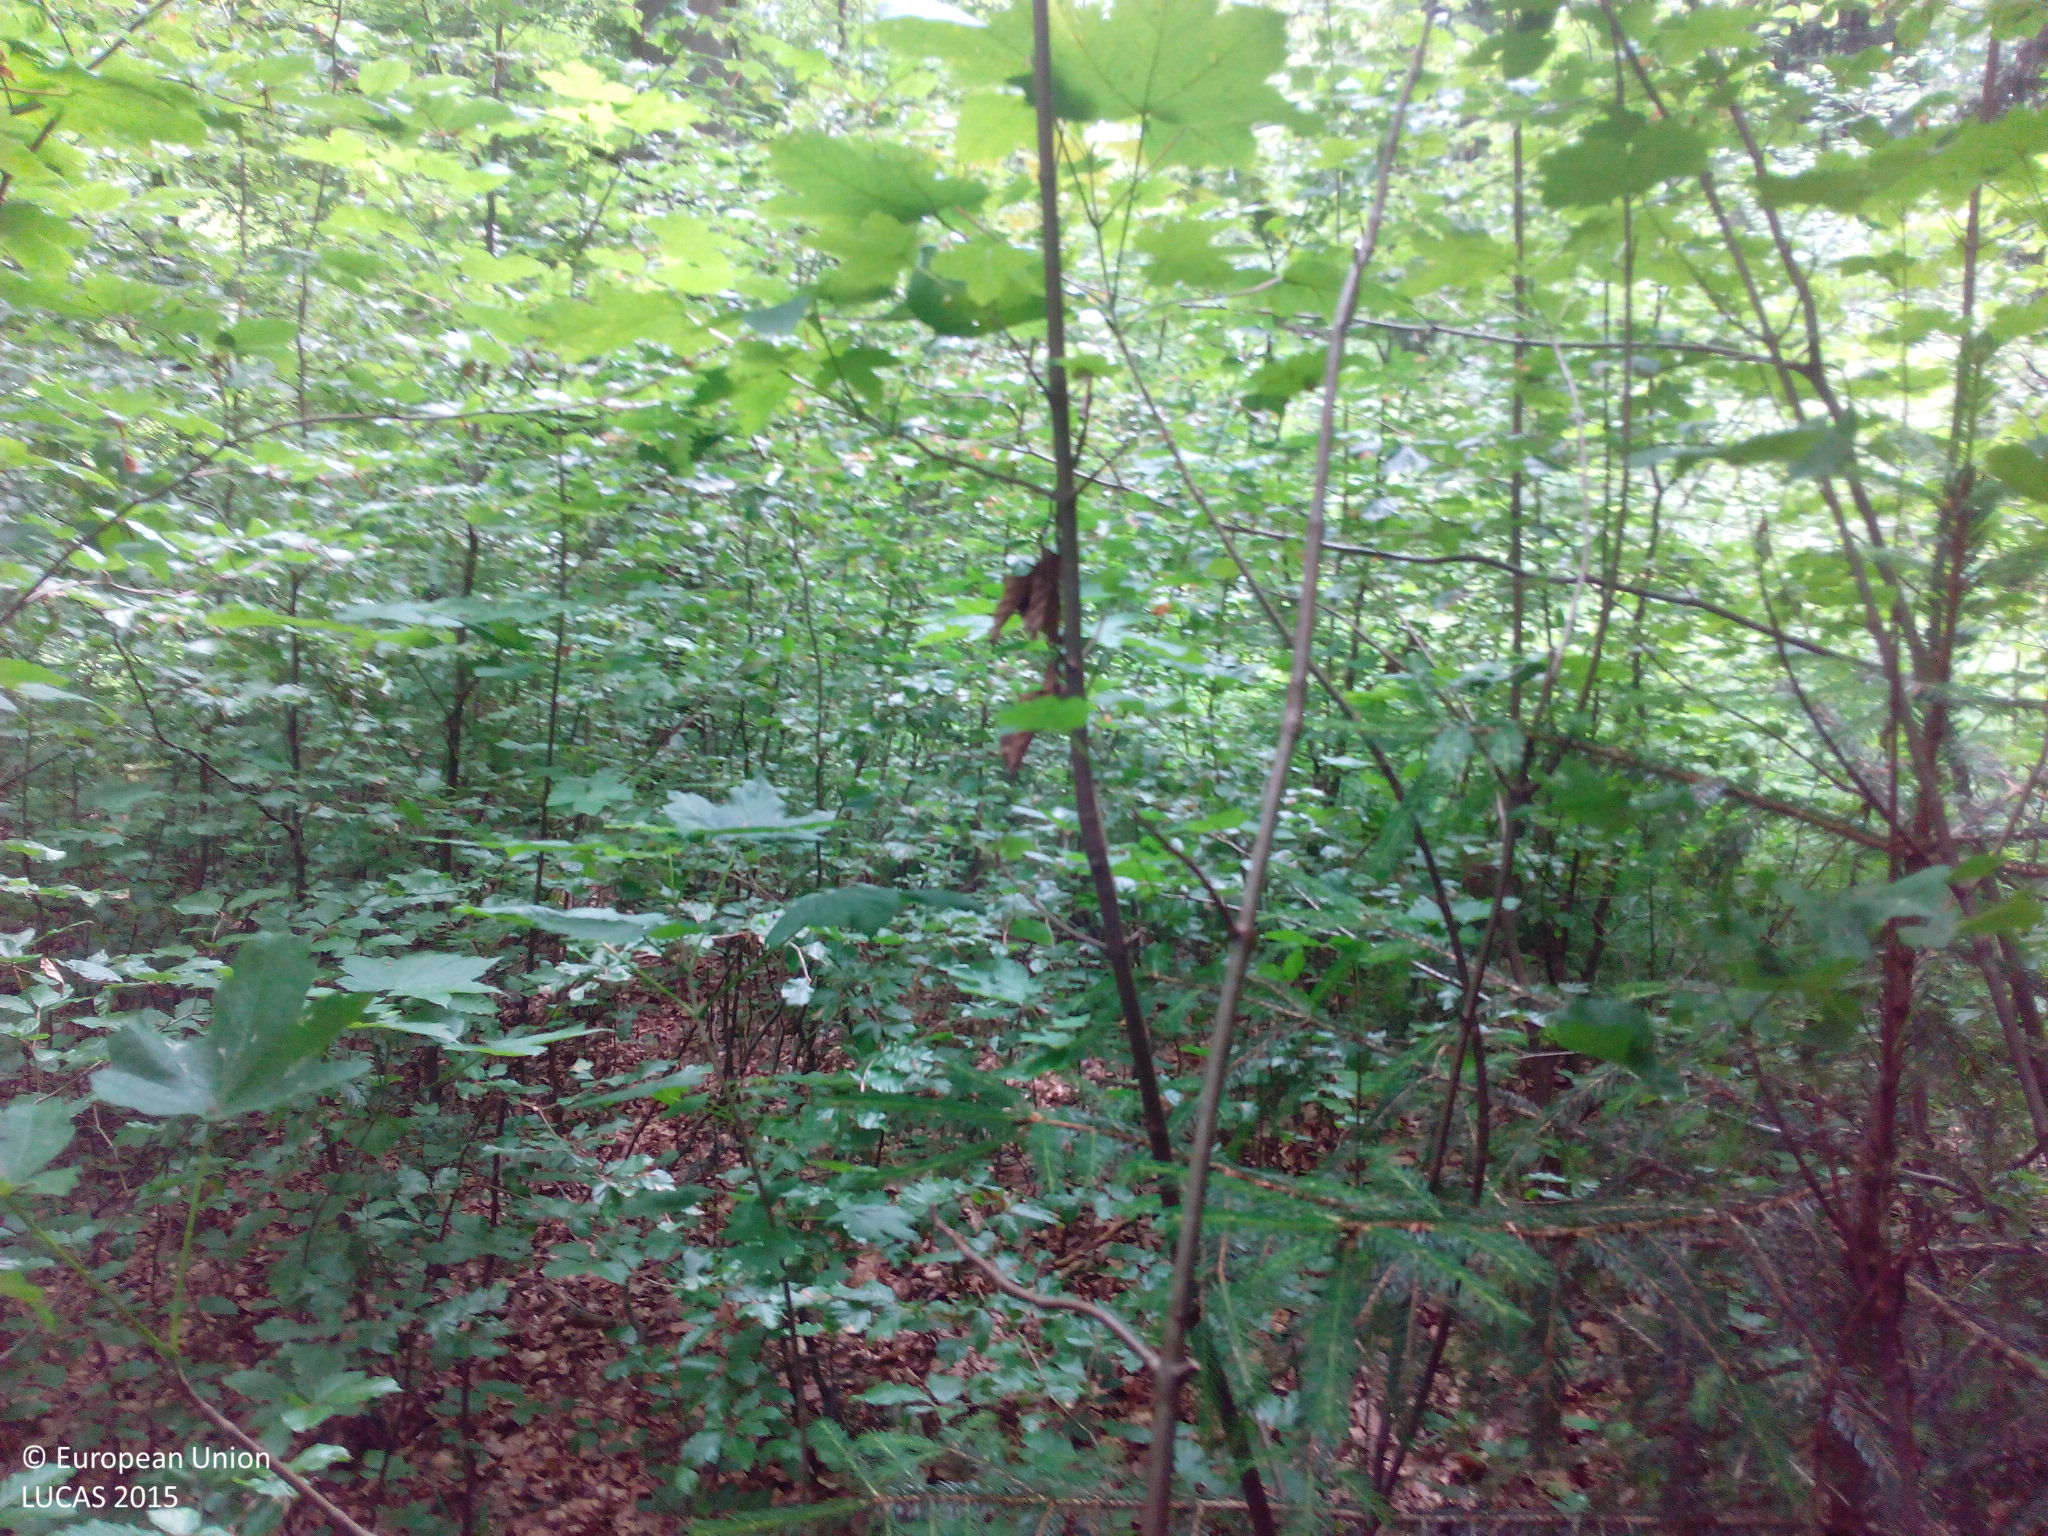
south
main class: Woodland
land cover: Broadleaved woodland
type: mesophytic deciduous forest
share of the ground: > 75 %
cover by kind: broadleaved forest trees 100 %
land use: Forestry
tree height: > 5 m
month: June
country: DE
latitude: 47.8991
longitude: 9.6658
